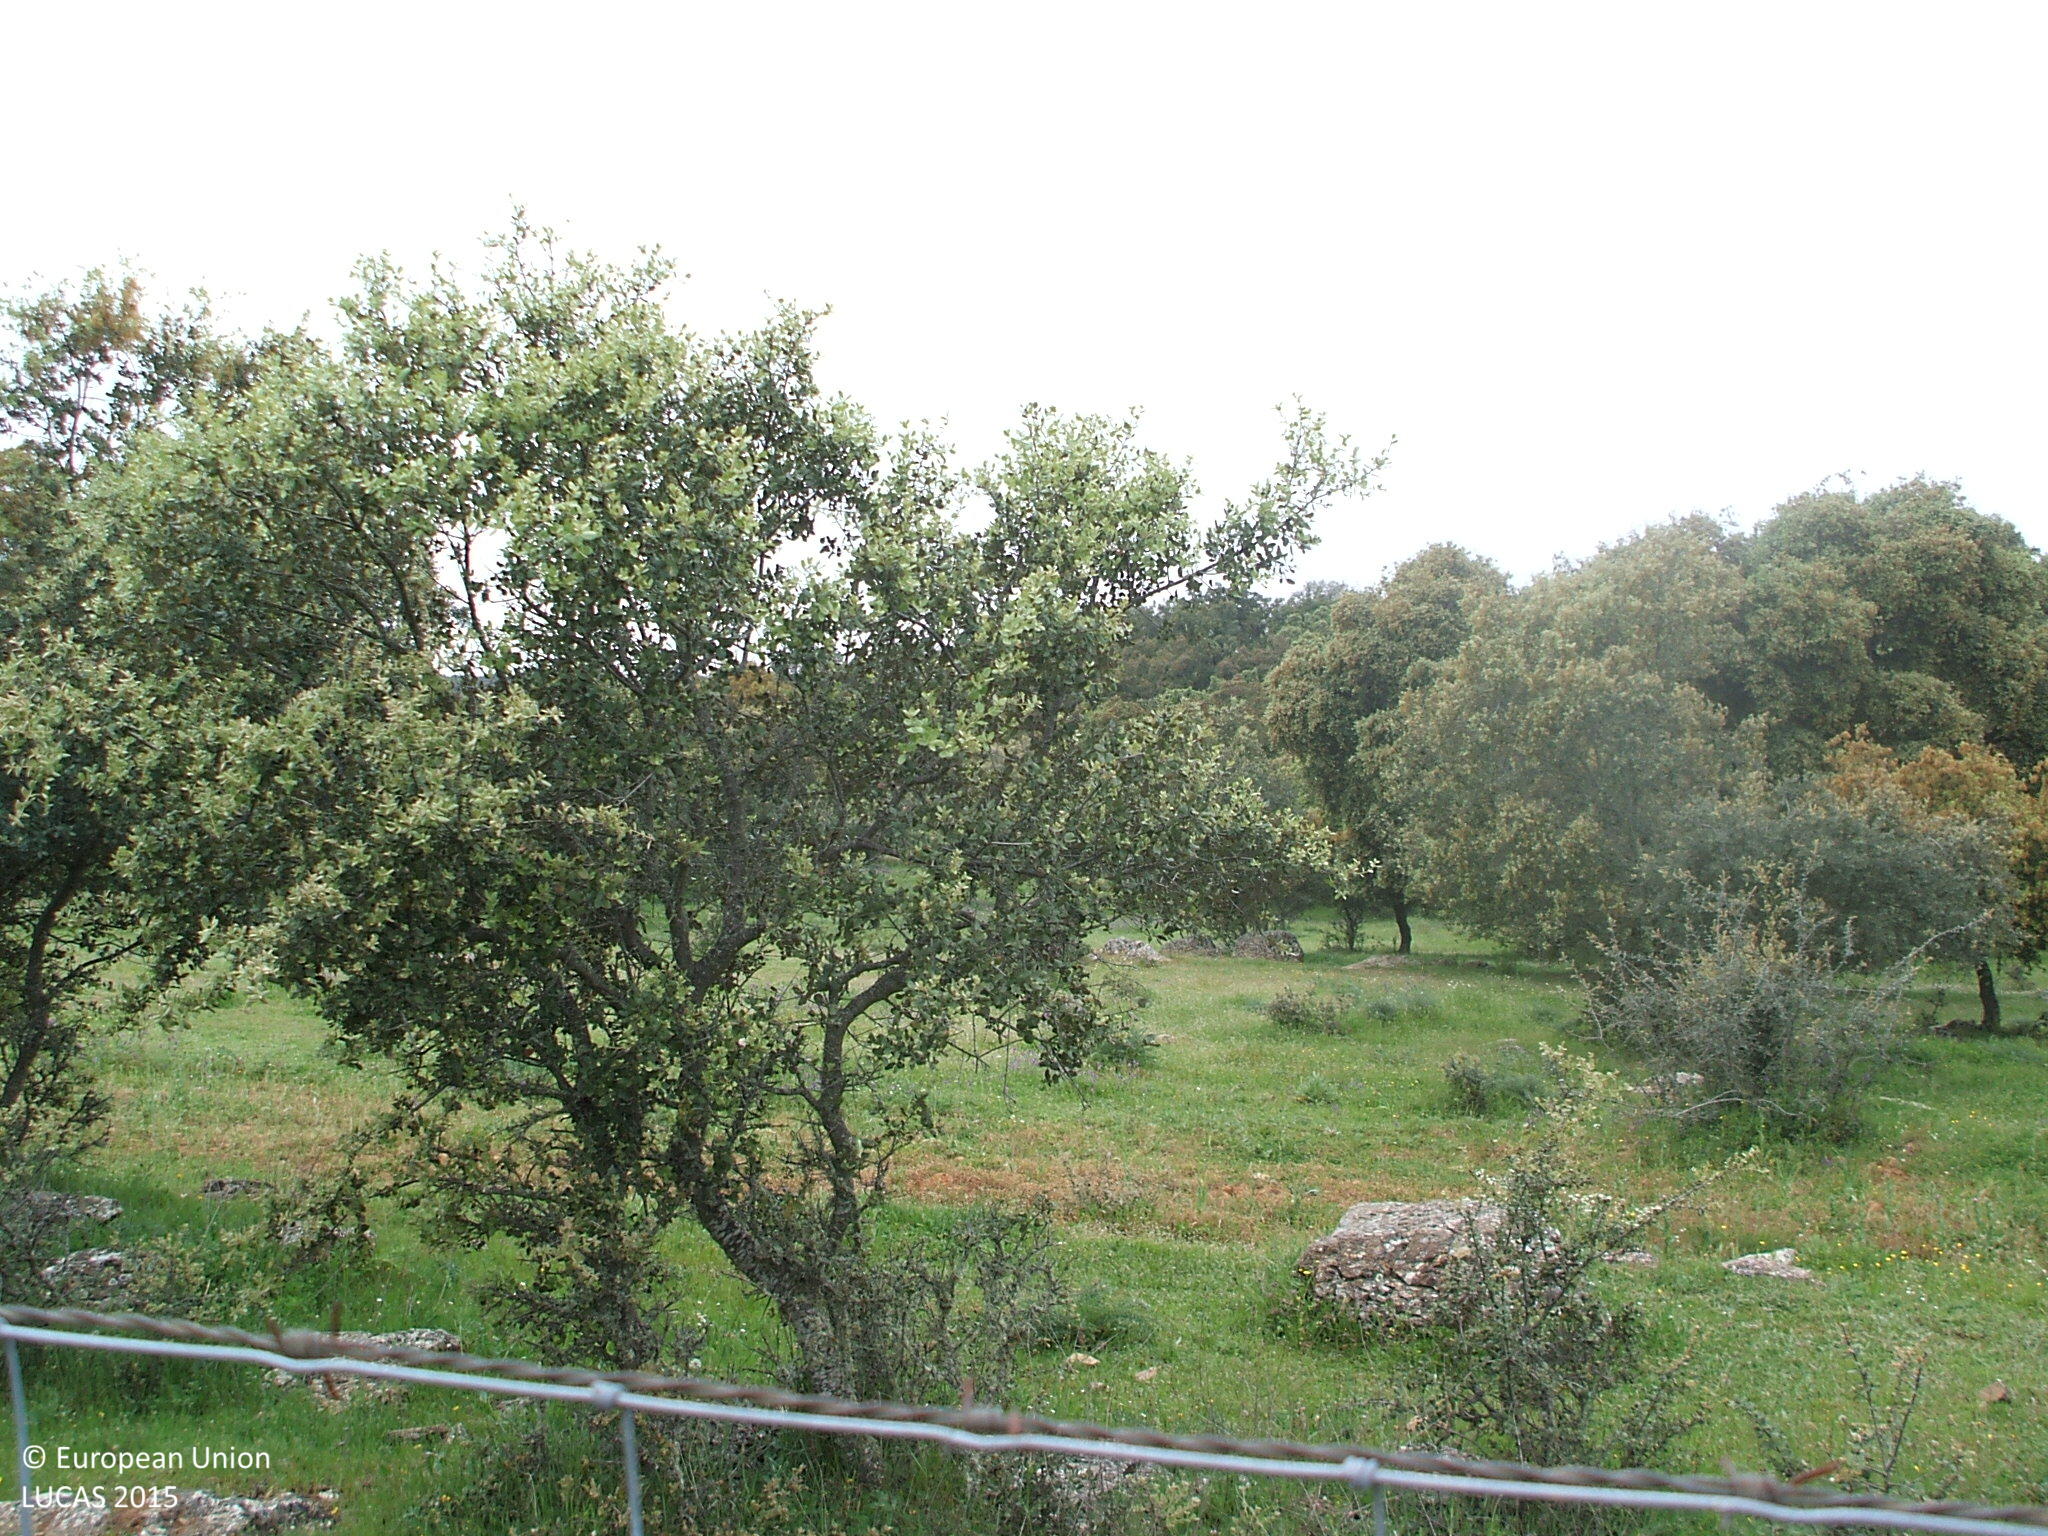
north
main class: Woodland
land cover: Broadleaved woodland
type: broadleaved evergreen forest
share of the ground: 10 - 25 %
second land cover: Grassland without tree/shrub cover
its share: > 75 %
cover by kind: herbaceous plants 80 %, broadleaved forest trees 20 %
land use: Forestry
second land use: Agriculture (excluding fallow land and kitchen gardens)
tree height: > 5 m
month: April
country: ES
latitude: 38.0416
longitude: -5.6750
